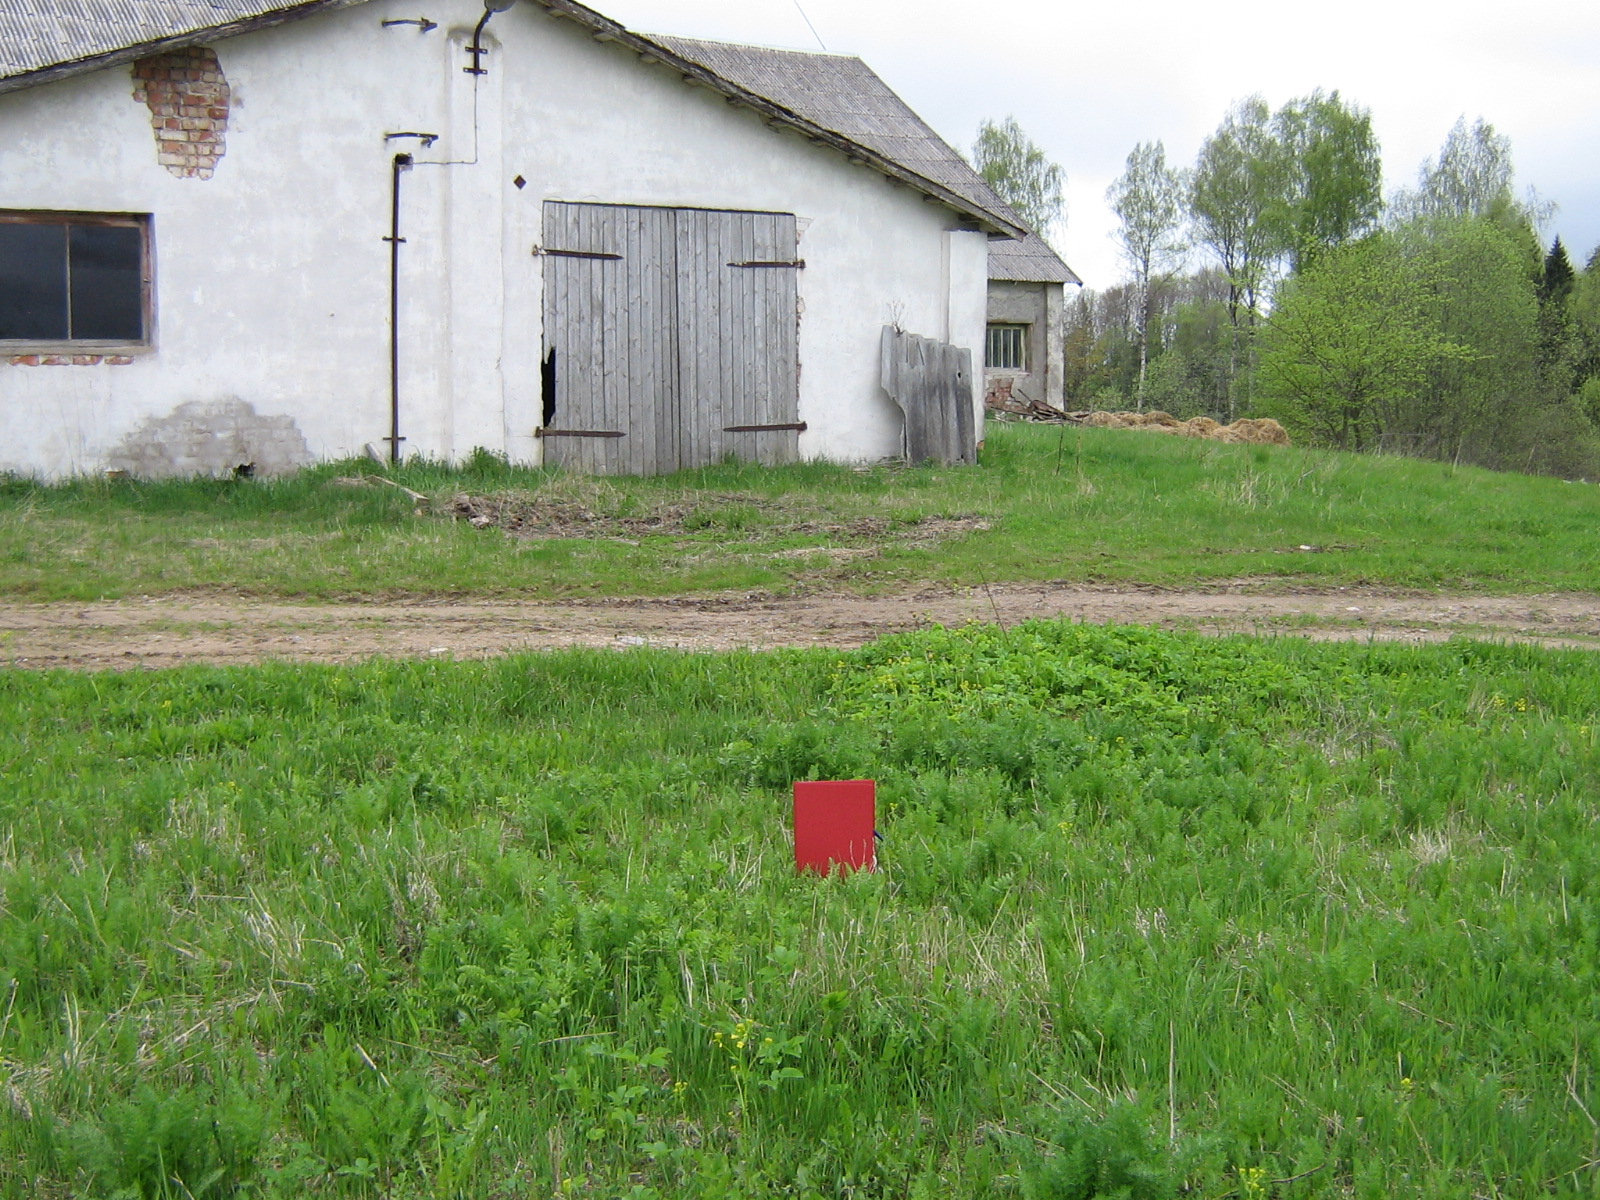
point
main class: Grassland
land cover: Grassland without tree/shrub cover
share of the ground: > 75 %
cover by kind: herbaceous plants 100 %
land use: Agriculture (excluding fallow land and kitchen gardens)
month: May
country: LV
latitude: 57.1692
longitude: 25.3103
